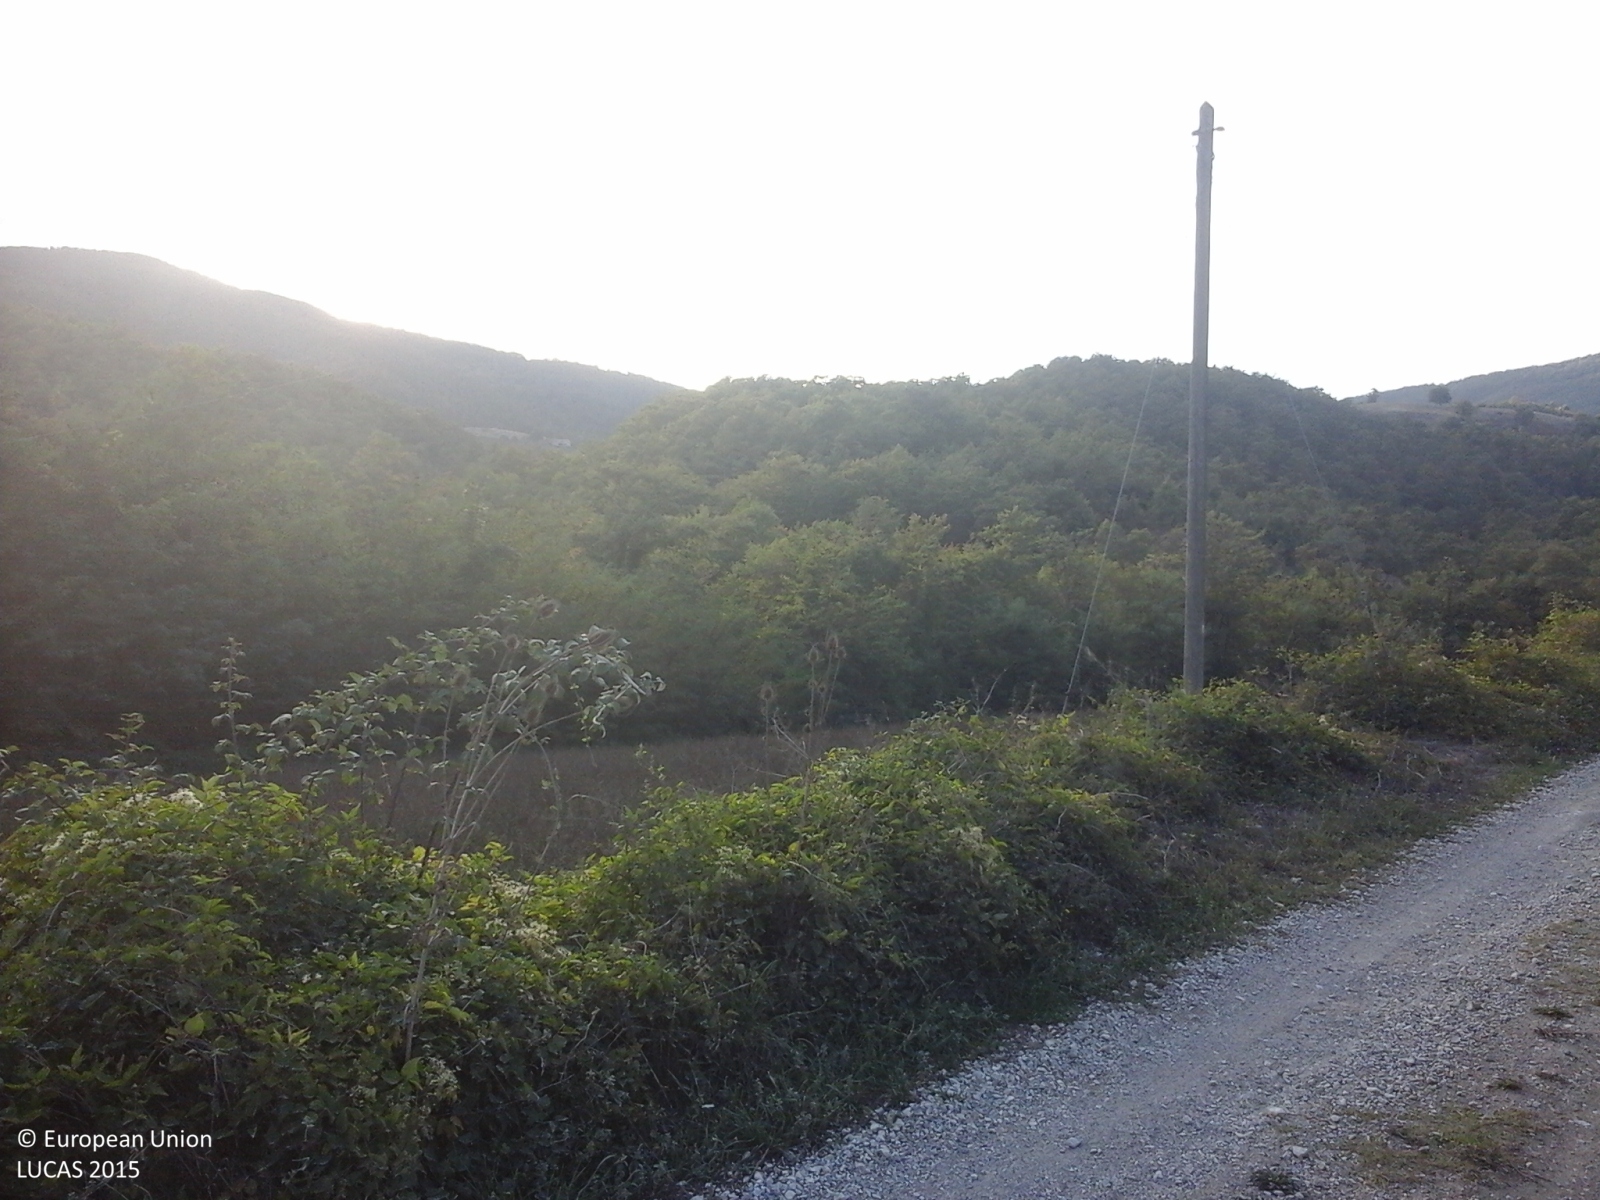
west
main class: Cropland
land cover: Olive groves
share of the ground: 25 - 50 %
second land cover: Grassland without tree/shrub cover
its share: > 75 %
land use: Agriculture (excluding fallow land and kitchen gardens)
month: October
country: IT
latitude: 43.2427
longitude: 12.2719
